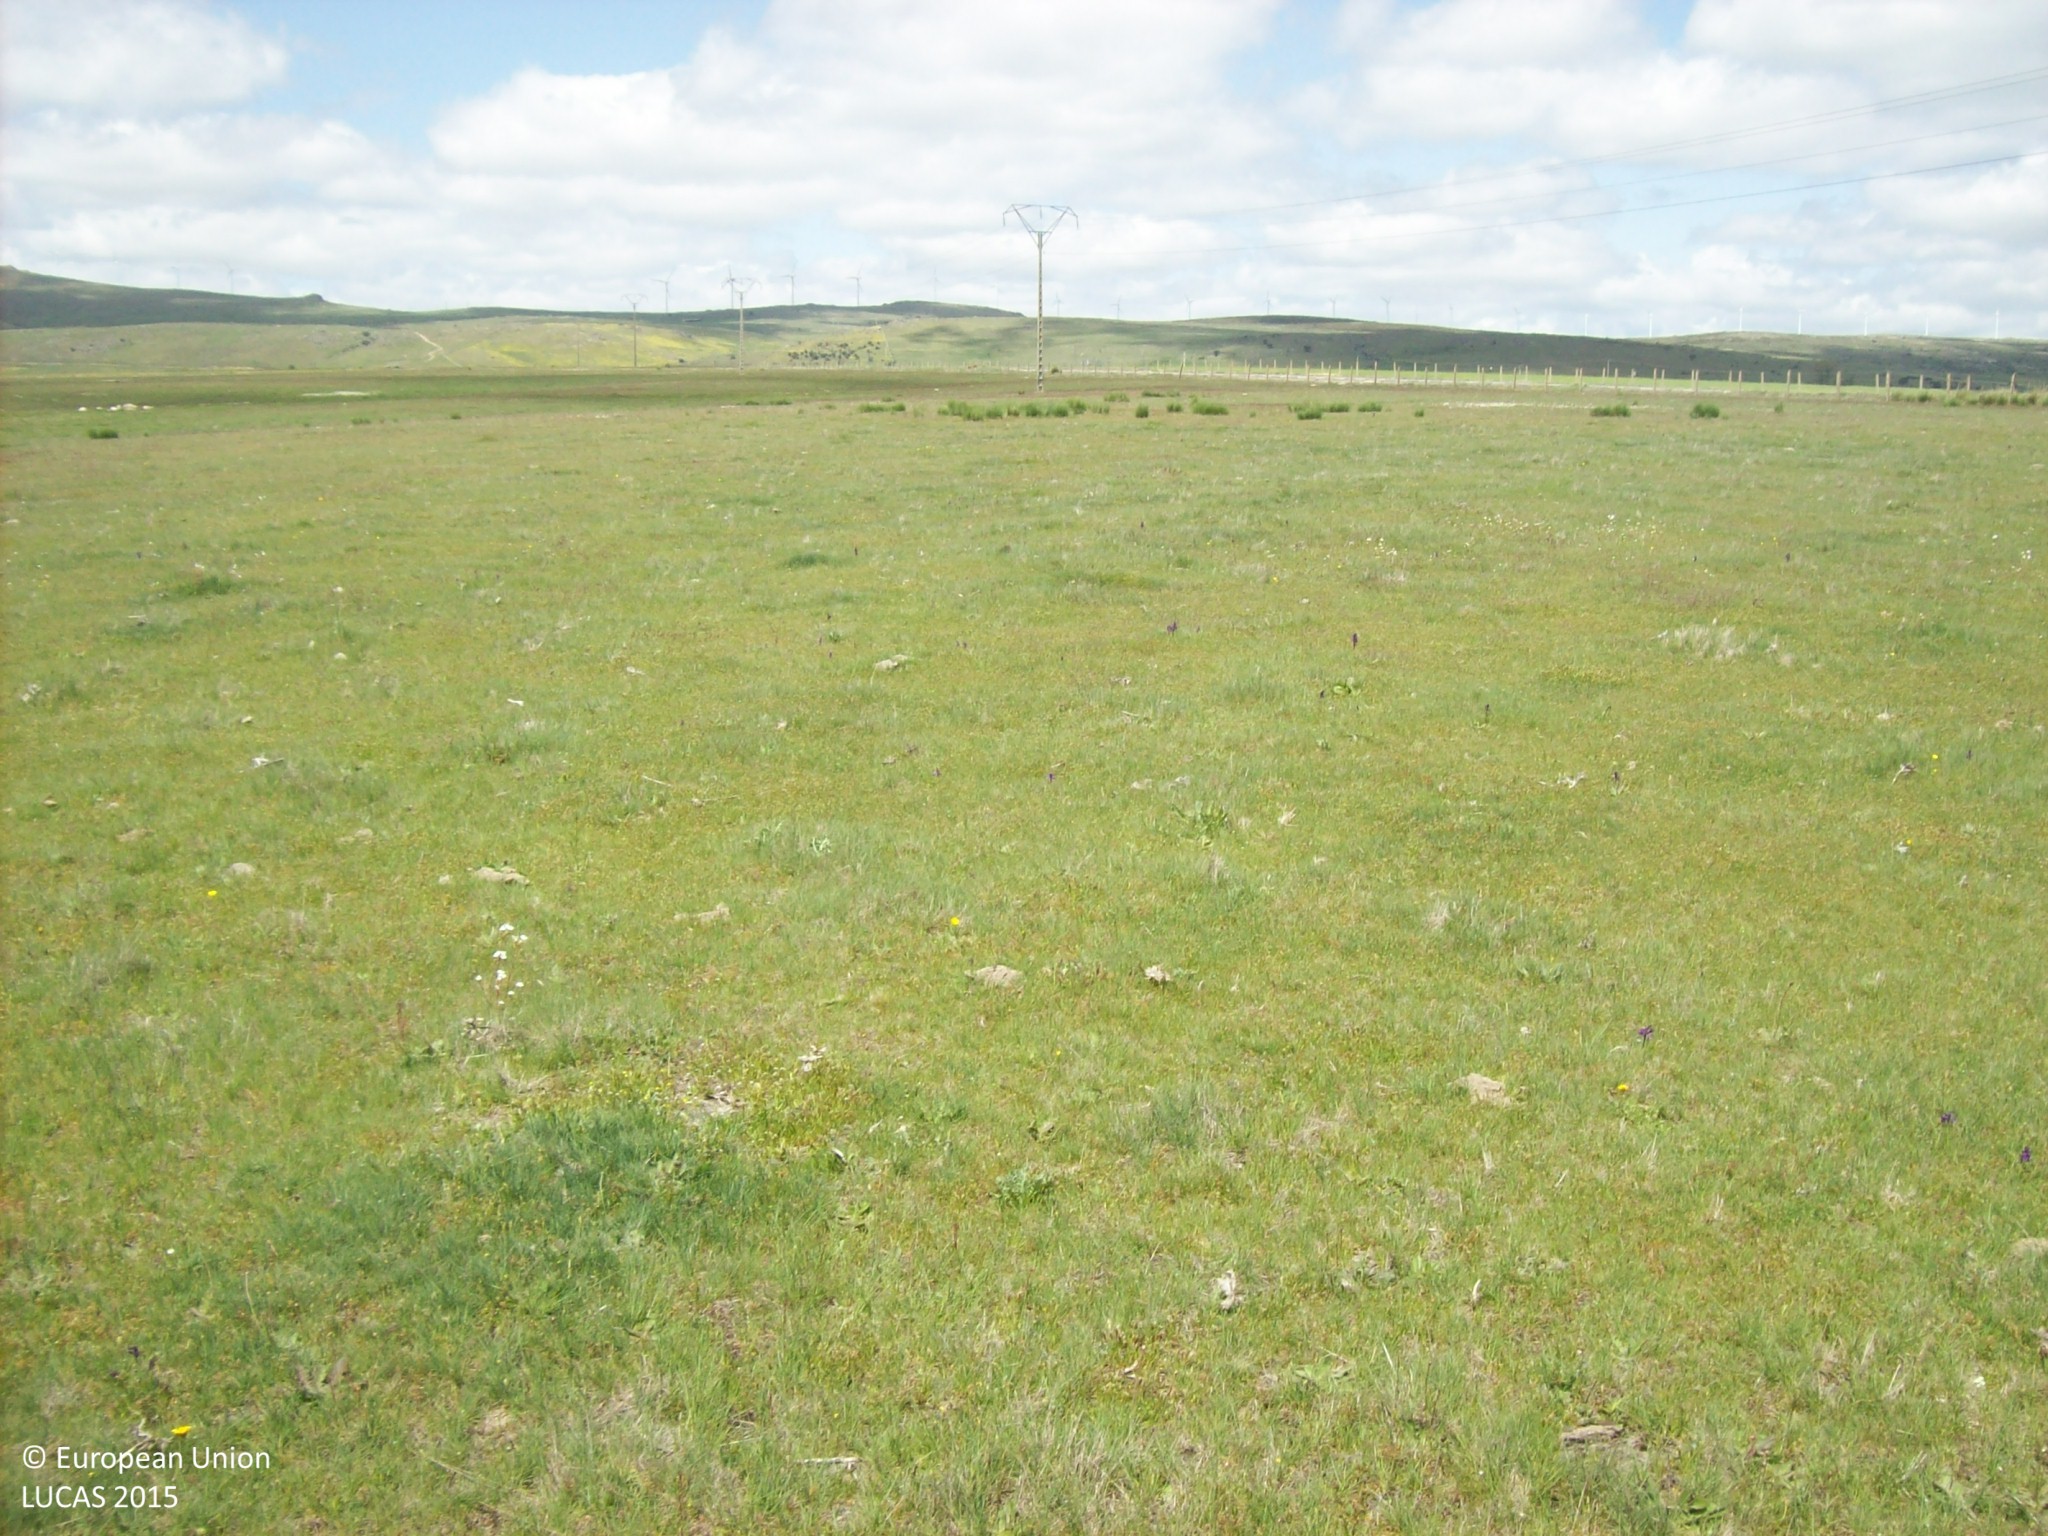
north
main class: Grassland
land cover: Grassland without tree/shrub cover
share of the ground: > 75 %
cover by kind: herbaceous plants 100 %
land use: Agriculture (excluding fallow land and kitchen gardens)
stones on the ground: < 10 %
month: May
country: ES
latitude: 40.6804
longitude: -4.4268
